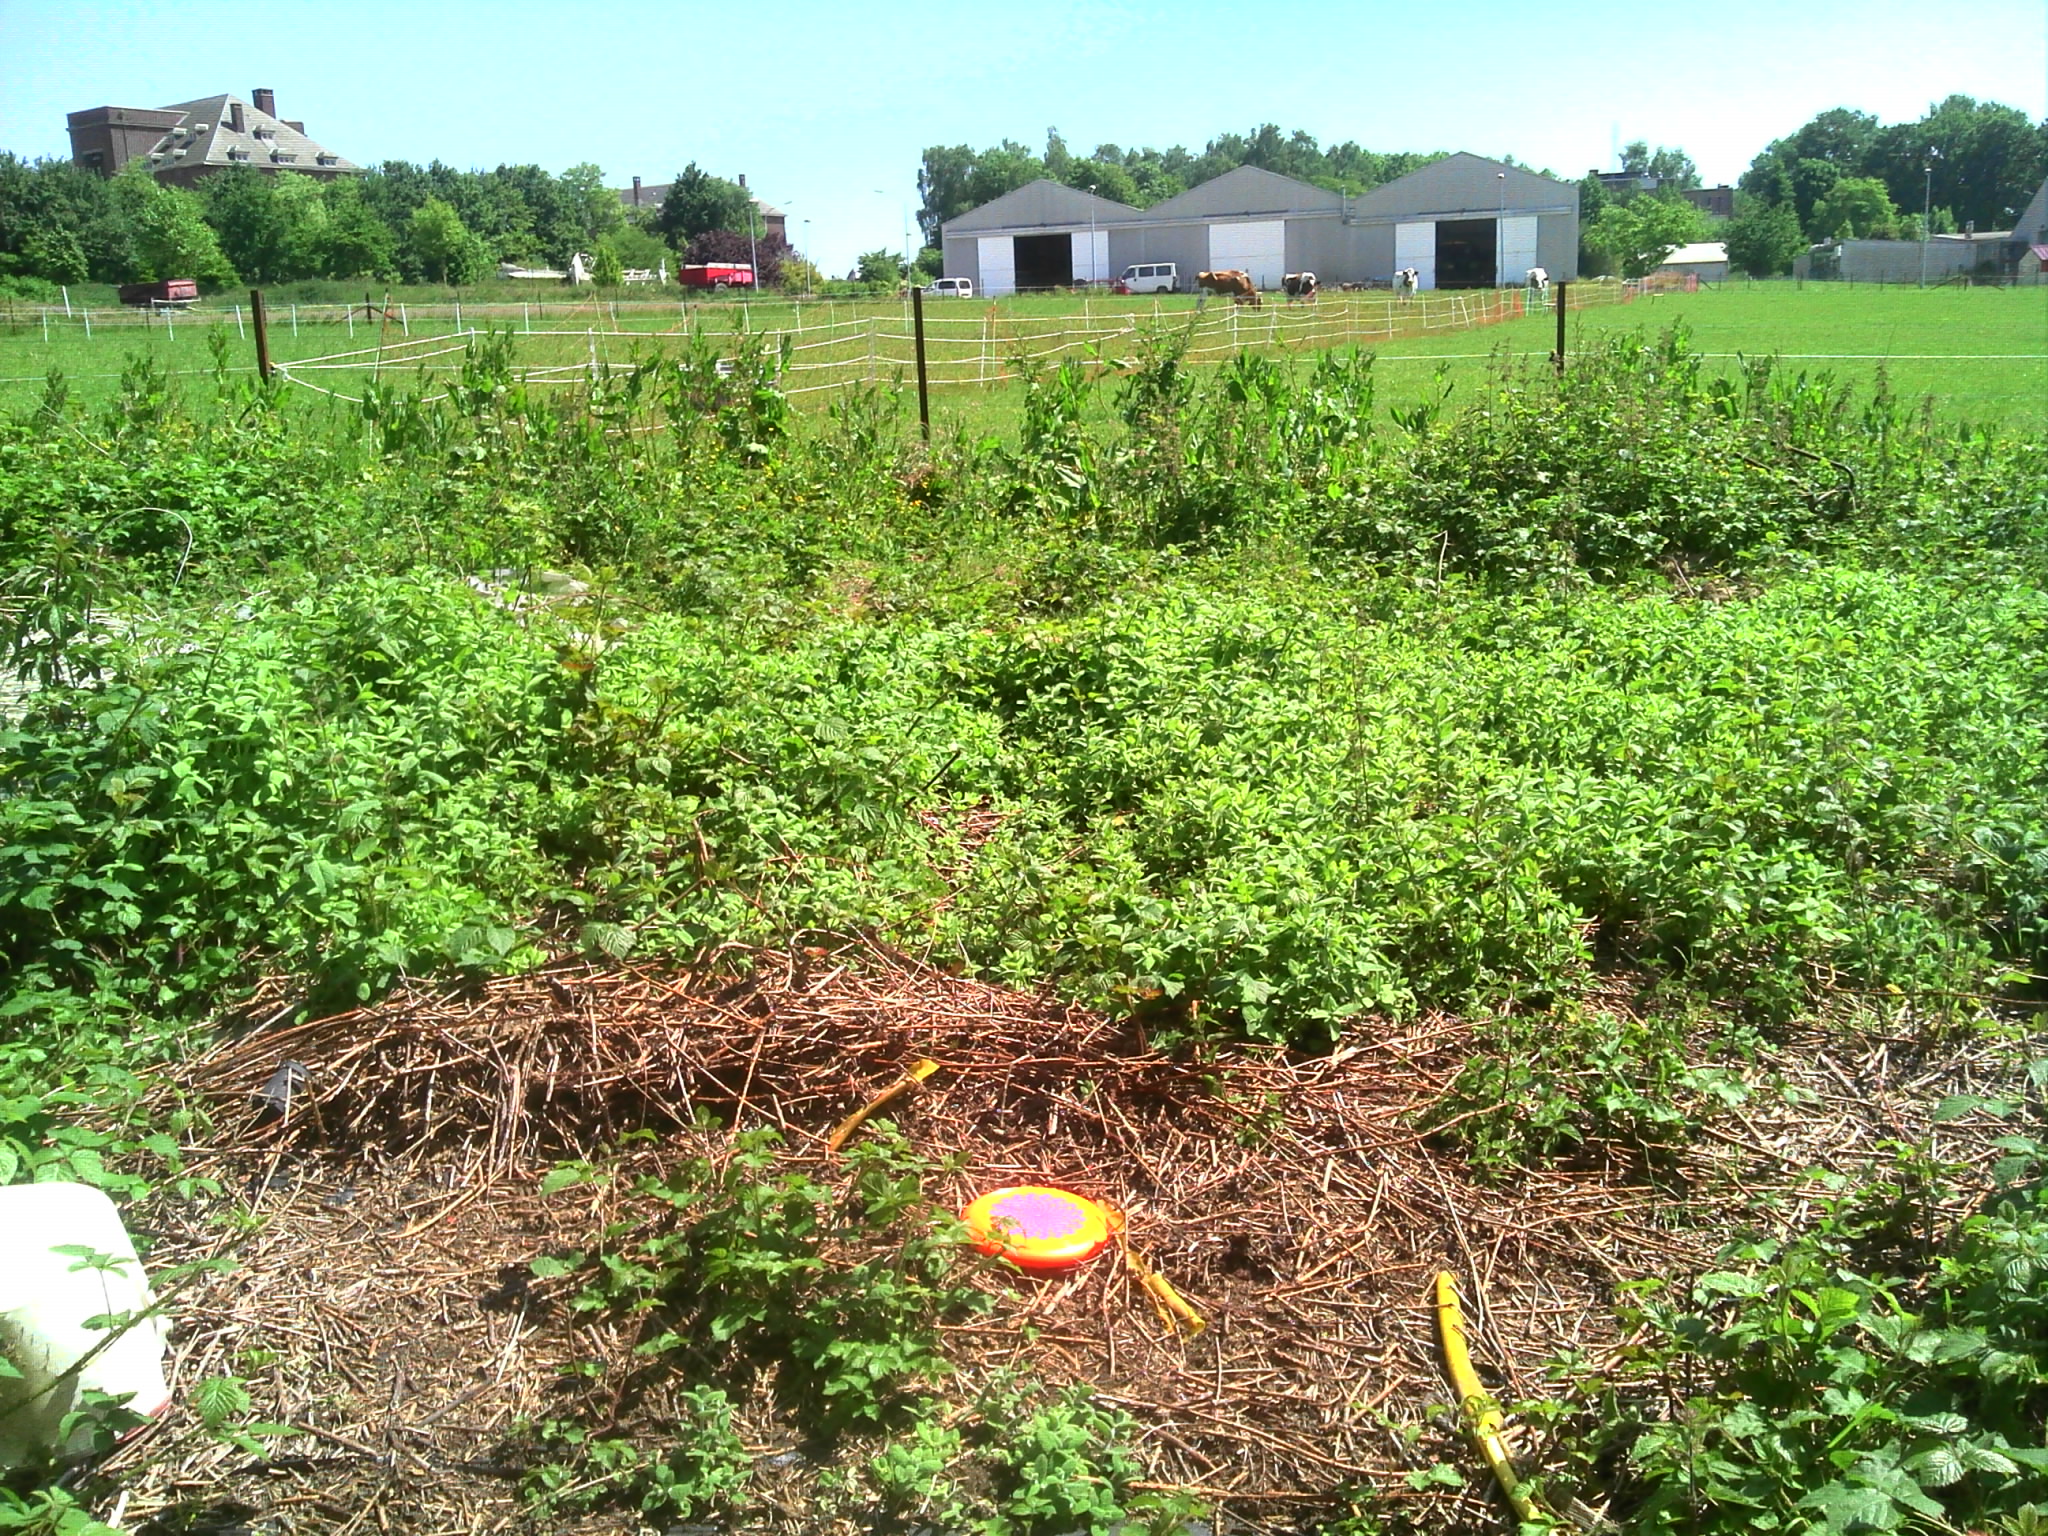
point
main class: Grassland
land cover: Spontaneously vegetated surfaces
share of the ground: 50 - 75 %
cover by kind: herbaceous plants 55 %, unconsolidated bare surface 40 %, shrubs 5 %
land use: Abandoned areas
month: June
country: BE
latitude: 50.5657
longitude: 4.7021
